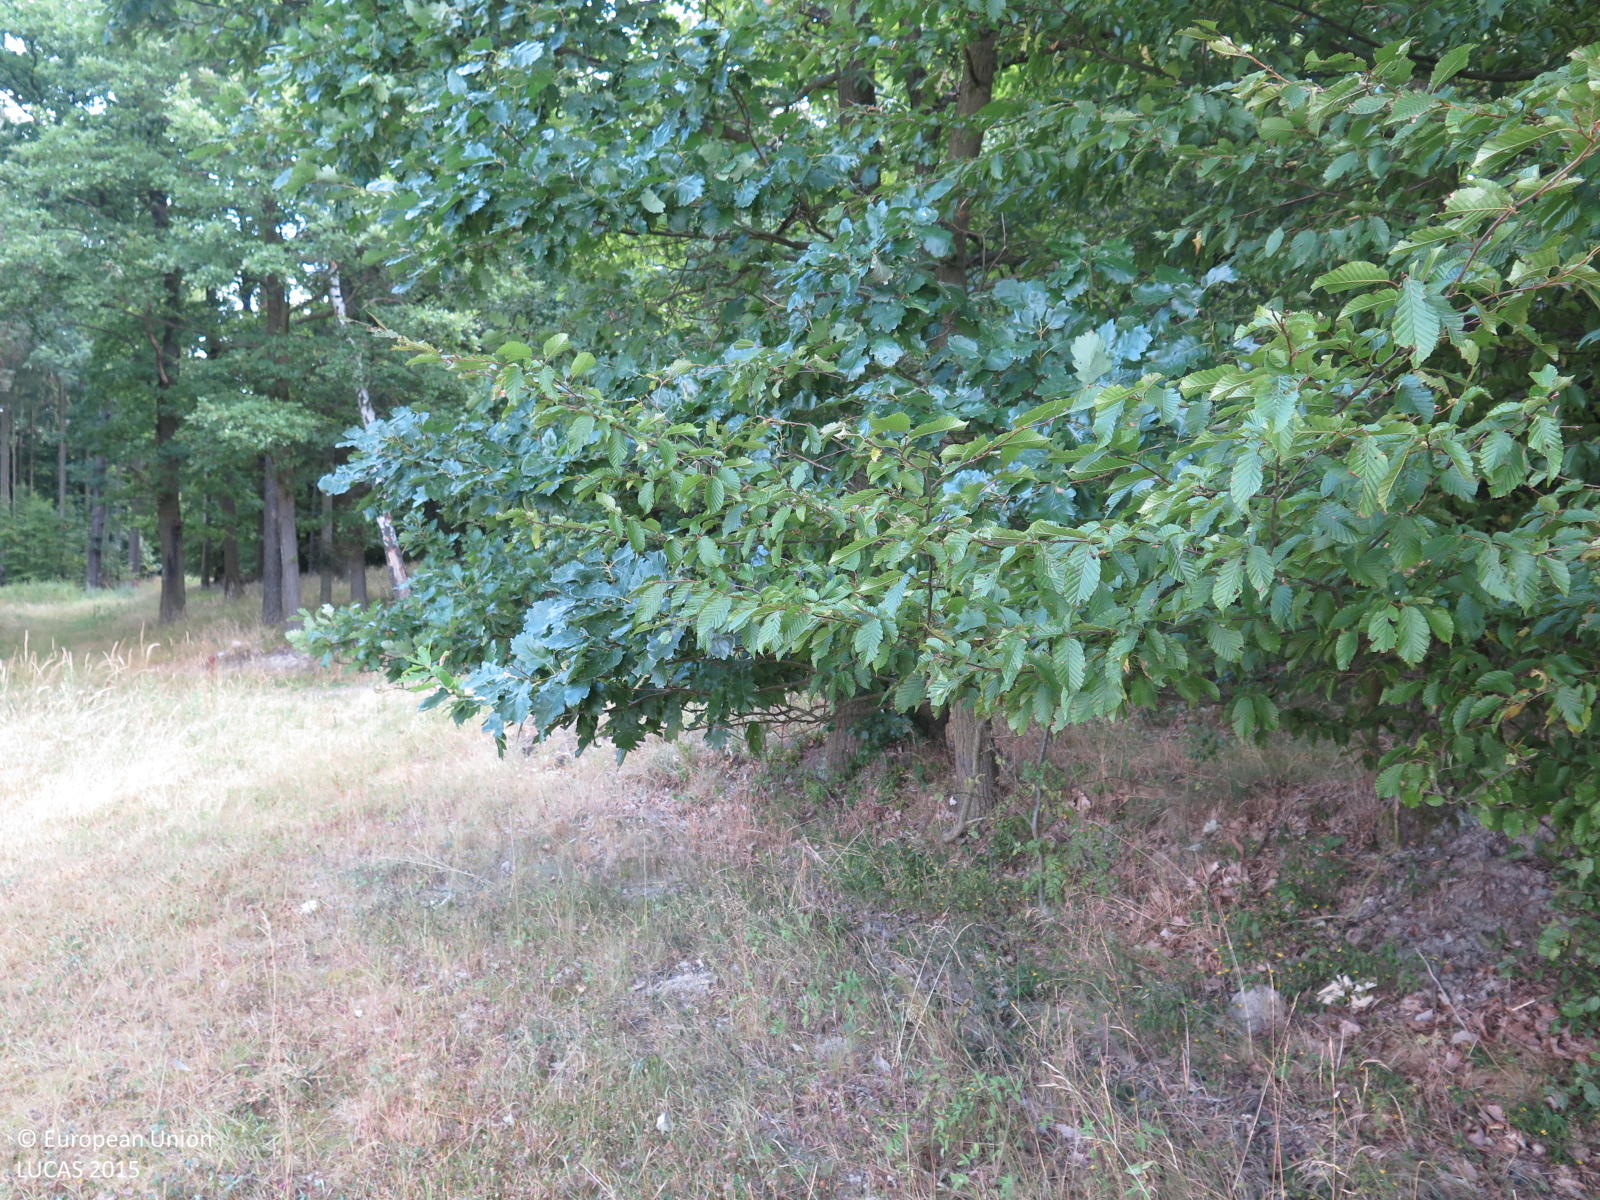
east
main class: Grassland
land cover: Grassland without tree/shrub cover
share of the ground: > 75 %
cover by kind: herbaceous plants 100 %
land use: Agriculture (excluding fallow land and kitchen gardens)
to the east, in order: Grassland without tree/shrub cover; Broadleaved woodland; Tracks; Broadleaved woodland; Grassland without tree/shrub cover; Tracks; Spruce dominated mixed woodland; Spruce dominated coniferous woodland; Spruce dominated mixed woodland; Spruce dominated coniferous woodland; Spruce dominated mixed woodland
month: August
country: CZ
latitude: 50.0476
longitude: 13.8410
